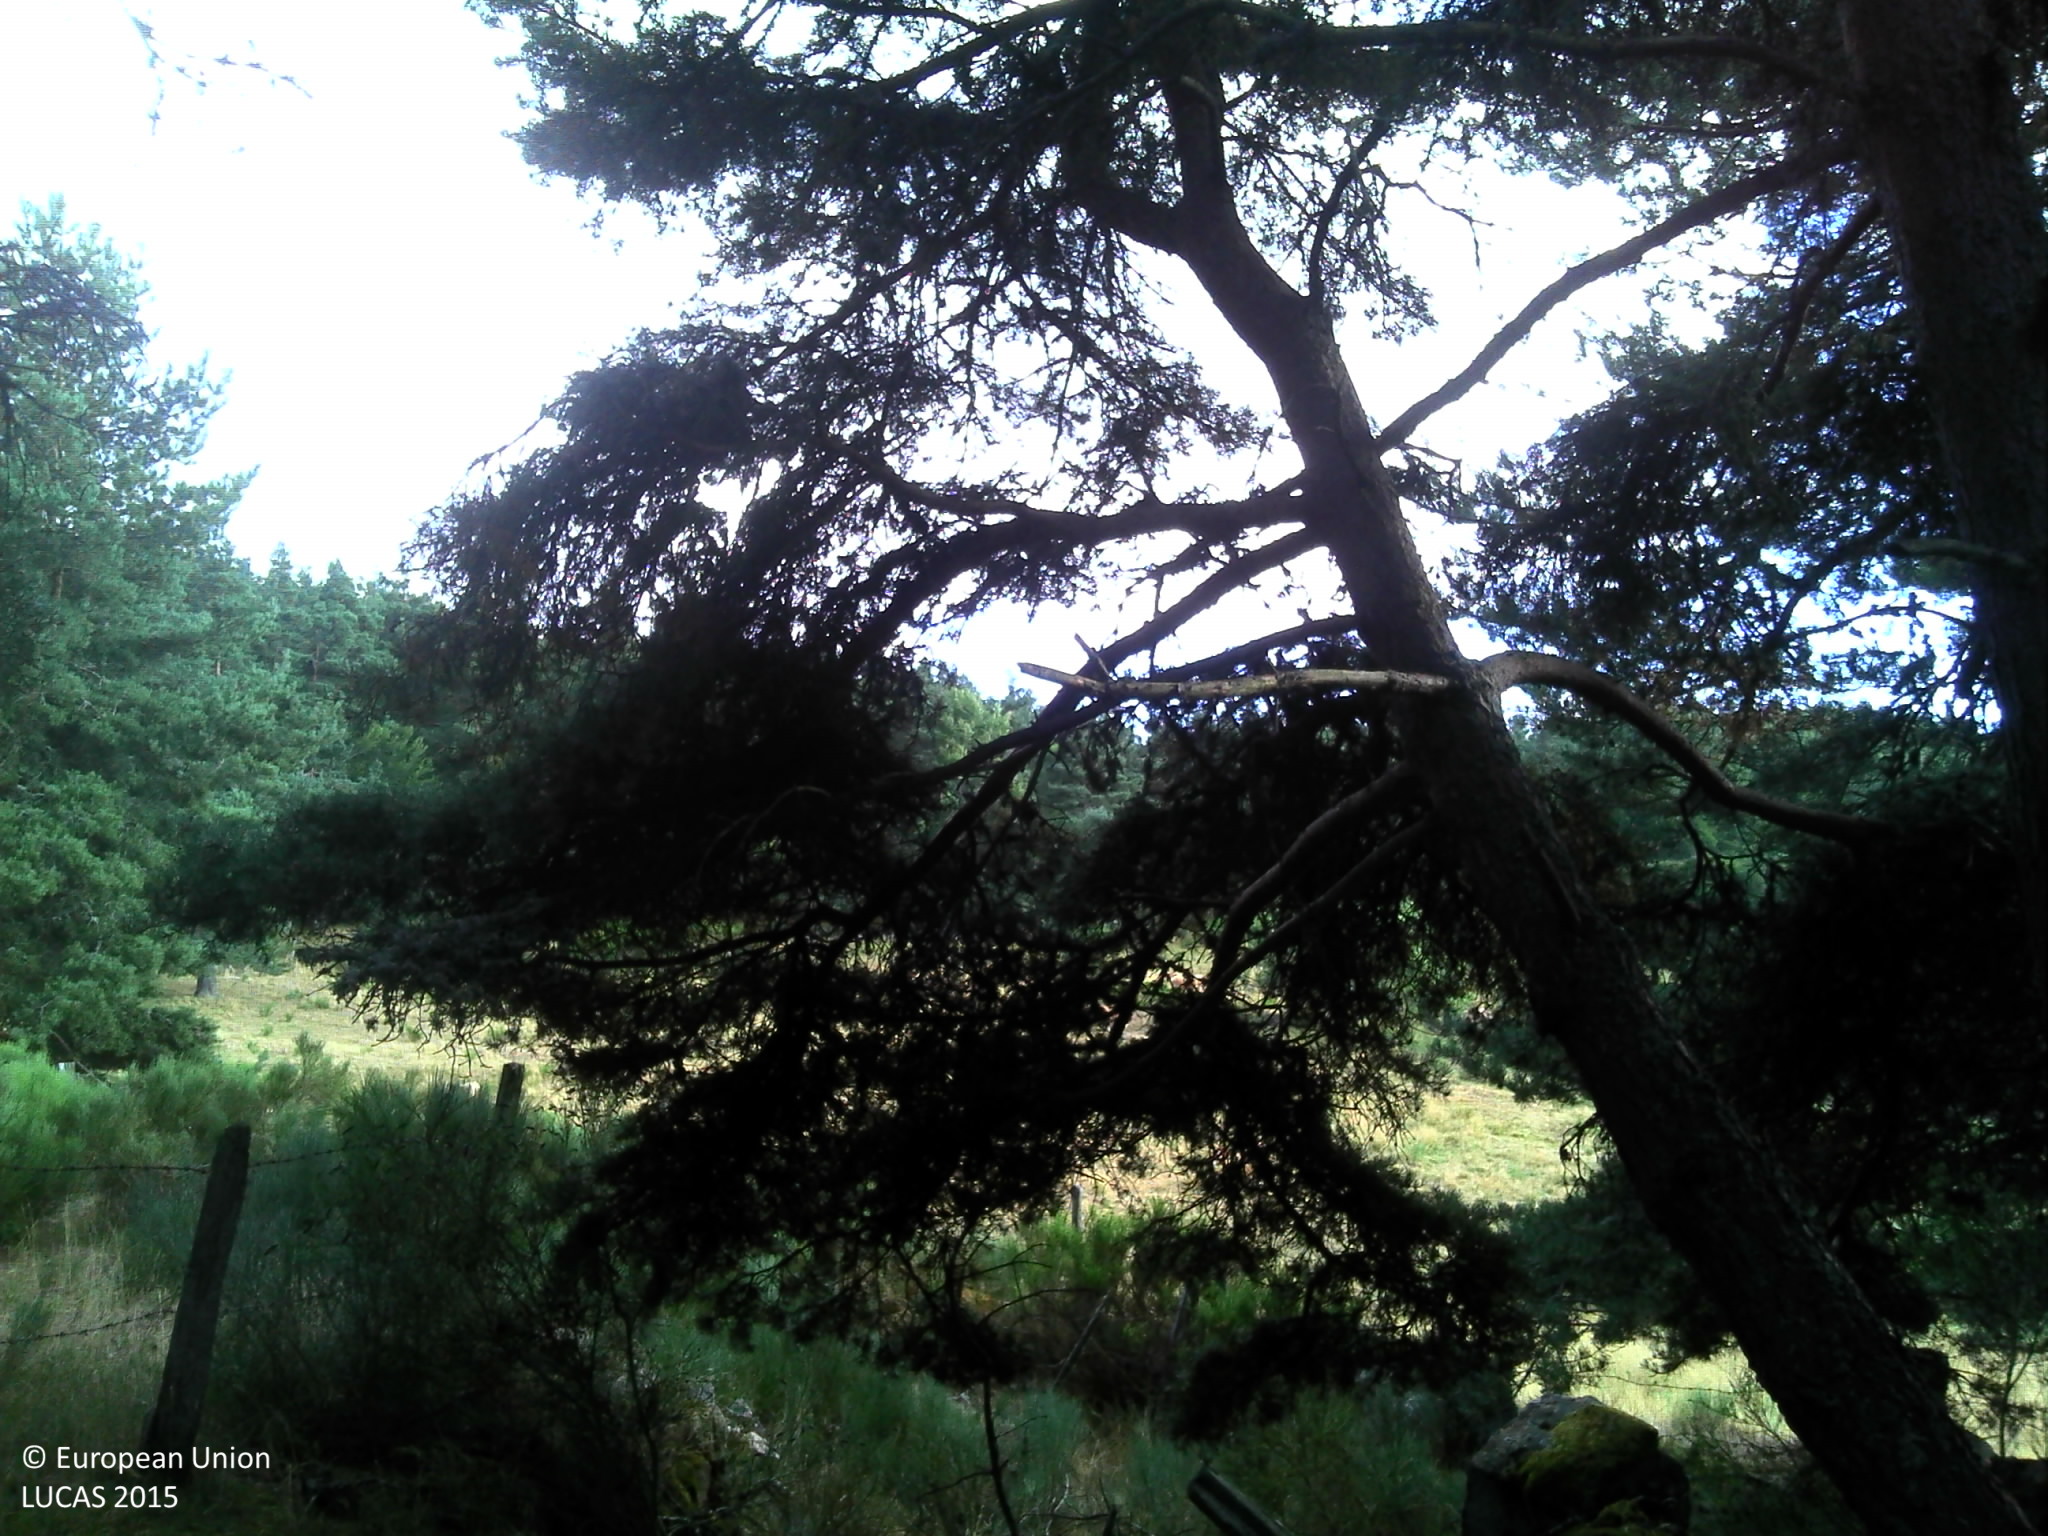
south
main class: Woodland
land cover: Pine dominated coniferous woodland
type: alpine coniferous forest
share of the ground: > 75 %
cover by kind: coniferous forest trees 95 %, broadleaved forest trees 5 %
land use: Forestry
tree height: > 5 m
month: July
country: FR
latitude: 44.7978
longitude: 3.2150
